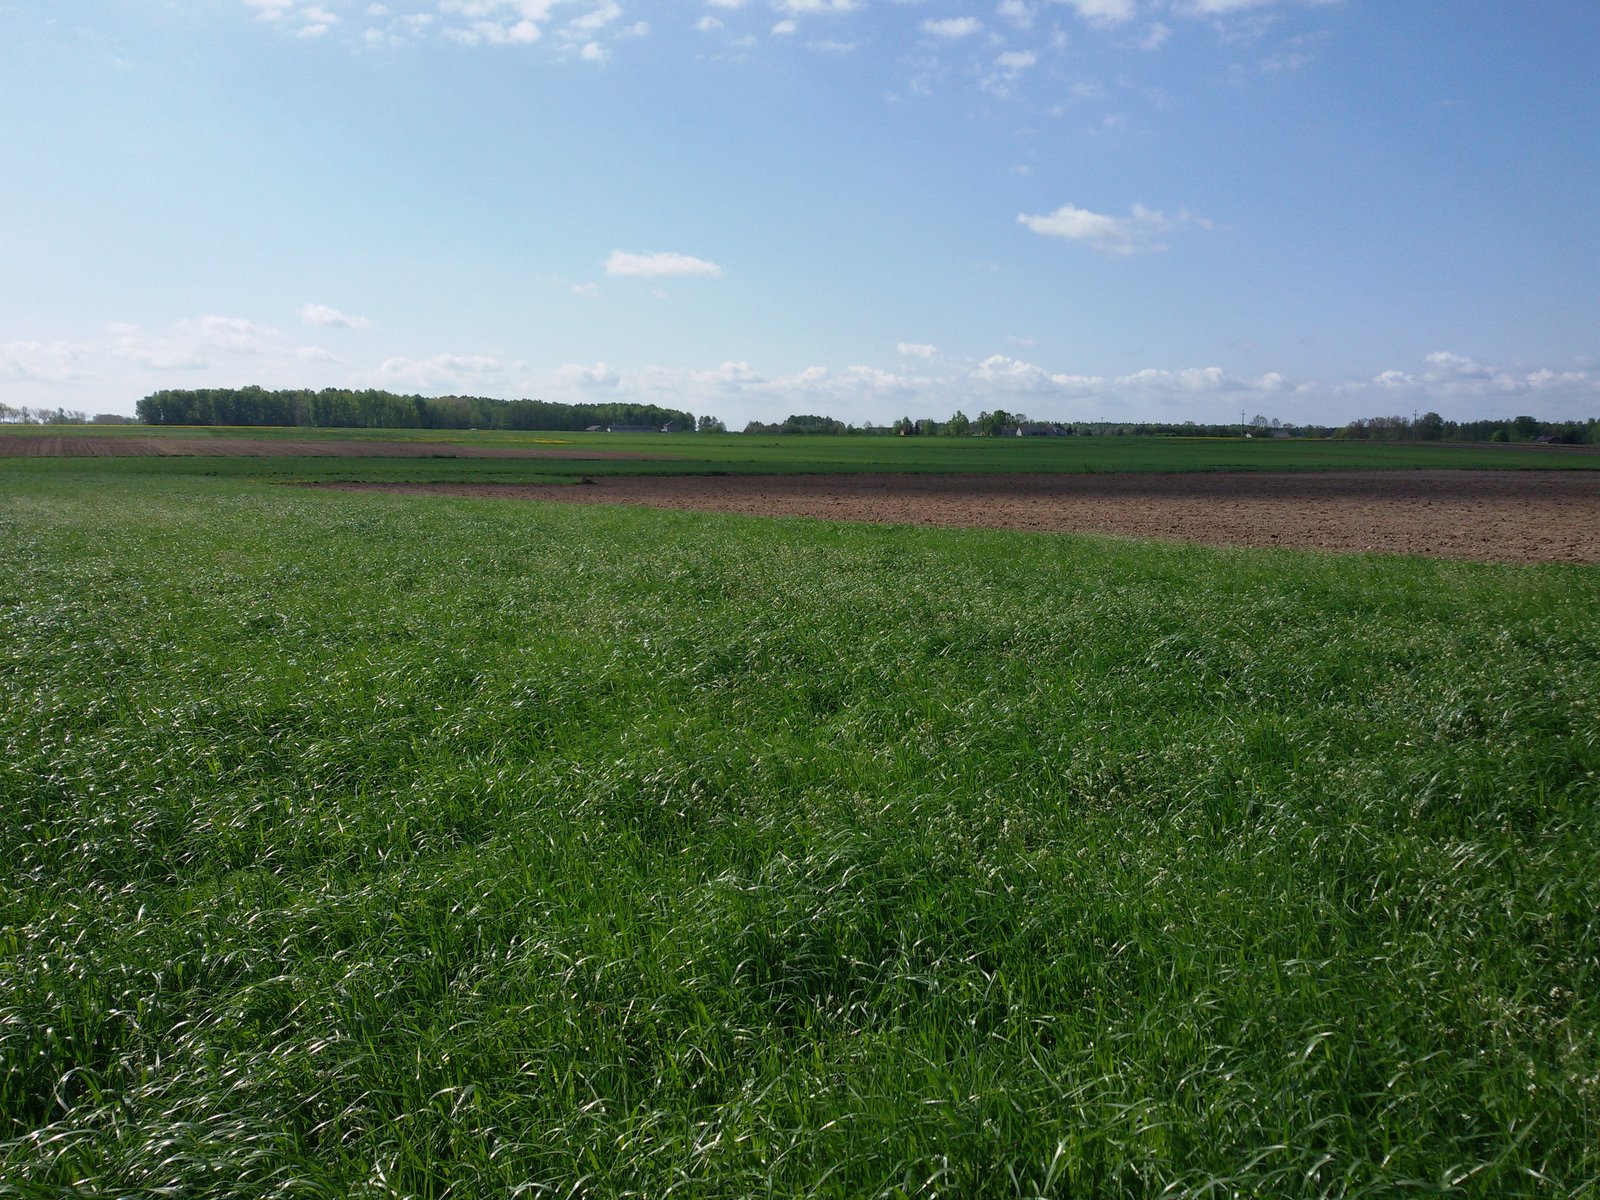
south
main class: Cropland
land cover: Temporary grasslands
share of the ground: > 75 %
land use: Agriculture (excluding fallow land and kitchen gardens)
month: May
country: PL
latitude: 52.9056
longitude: 22.2388
